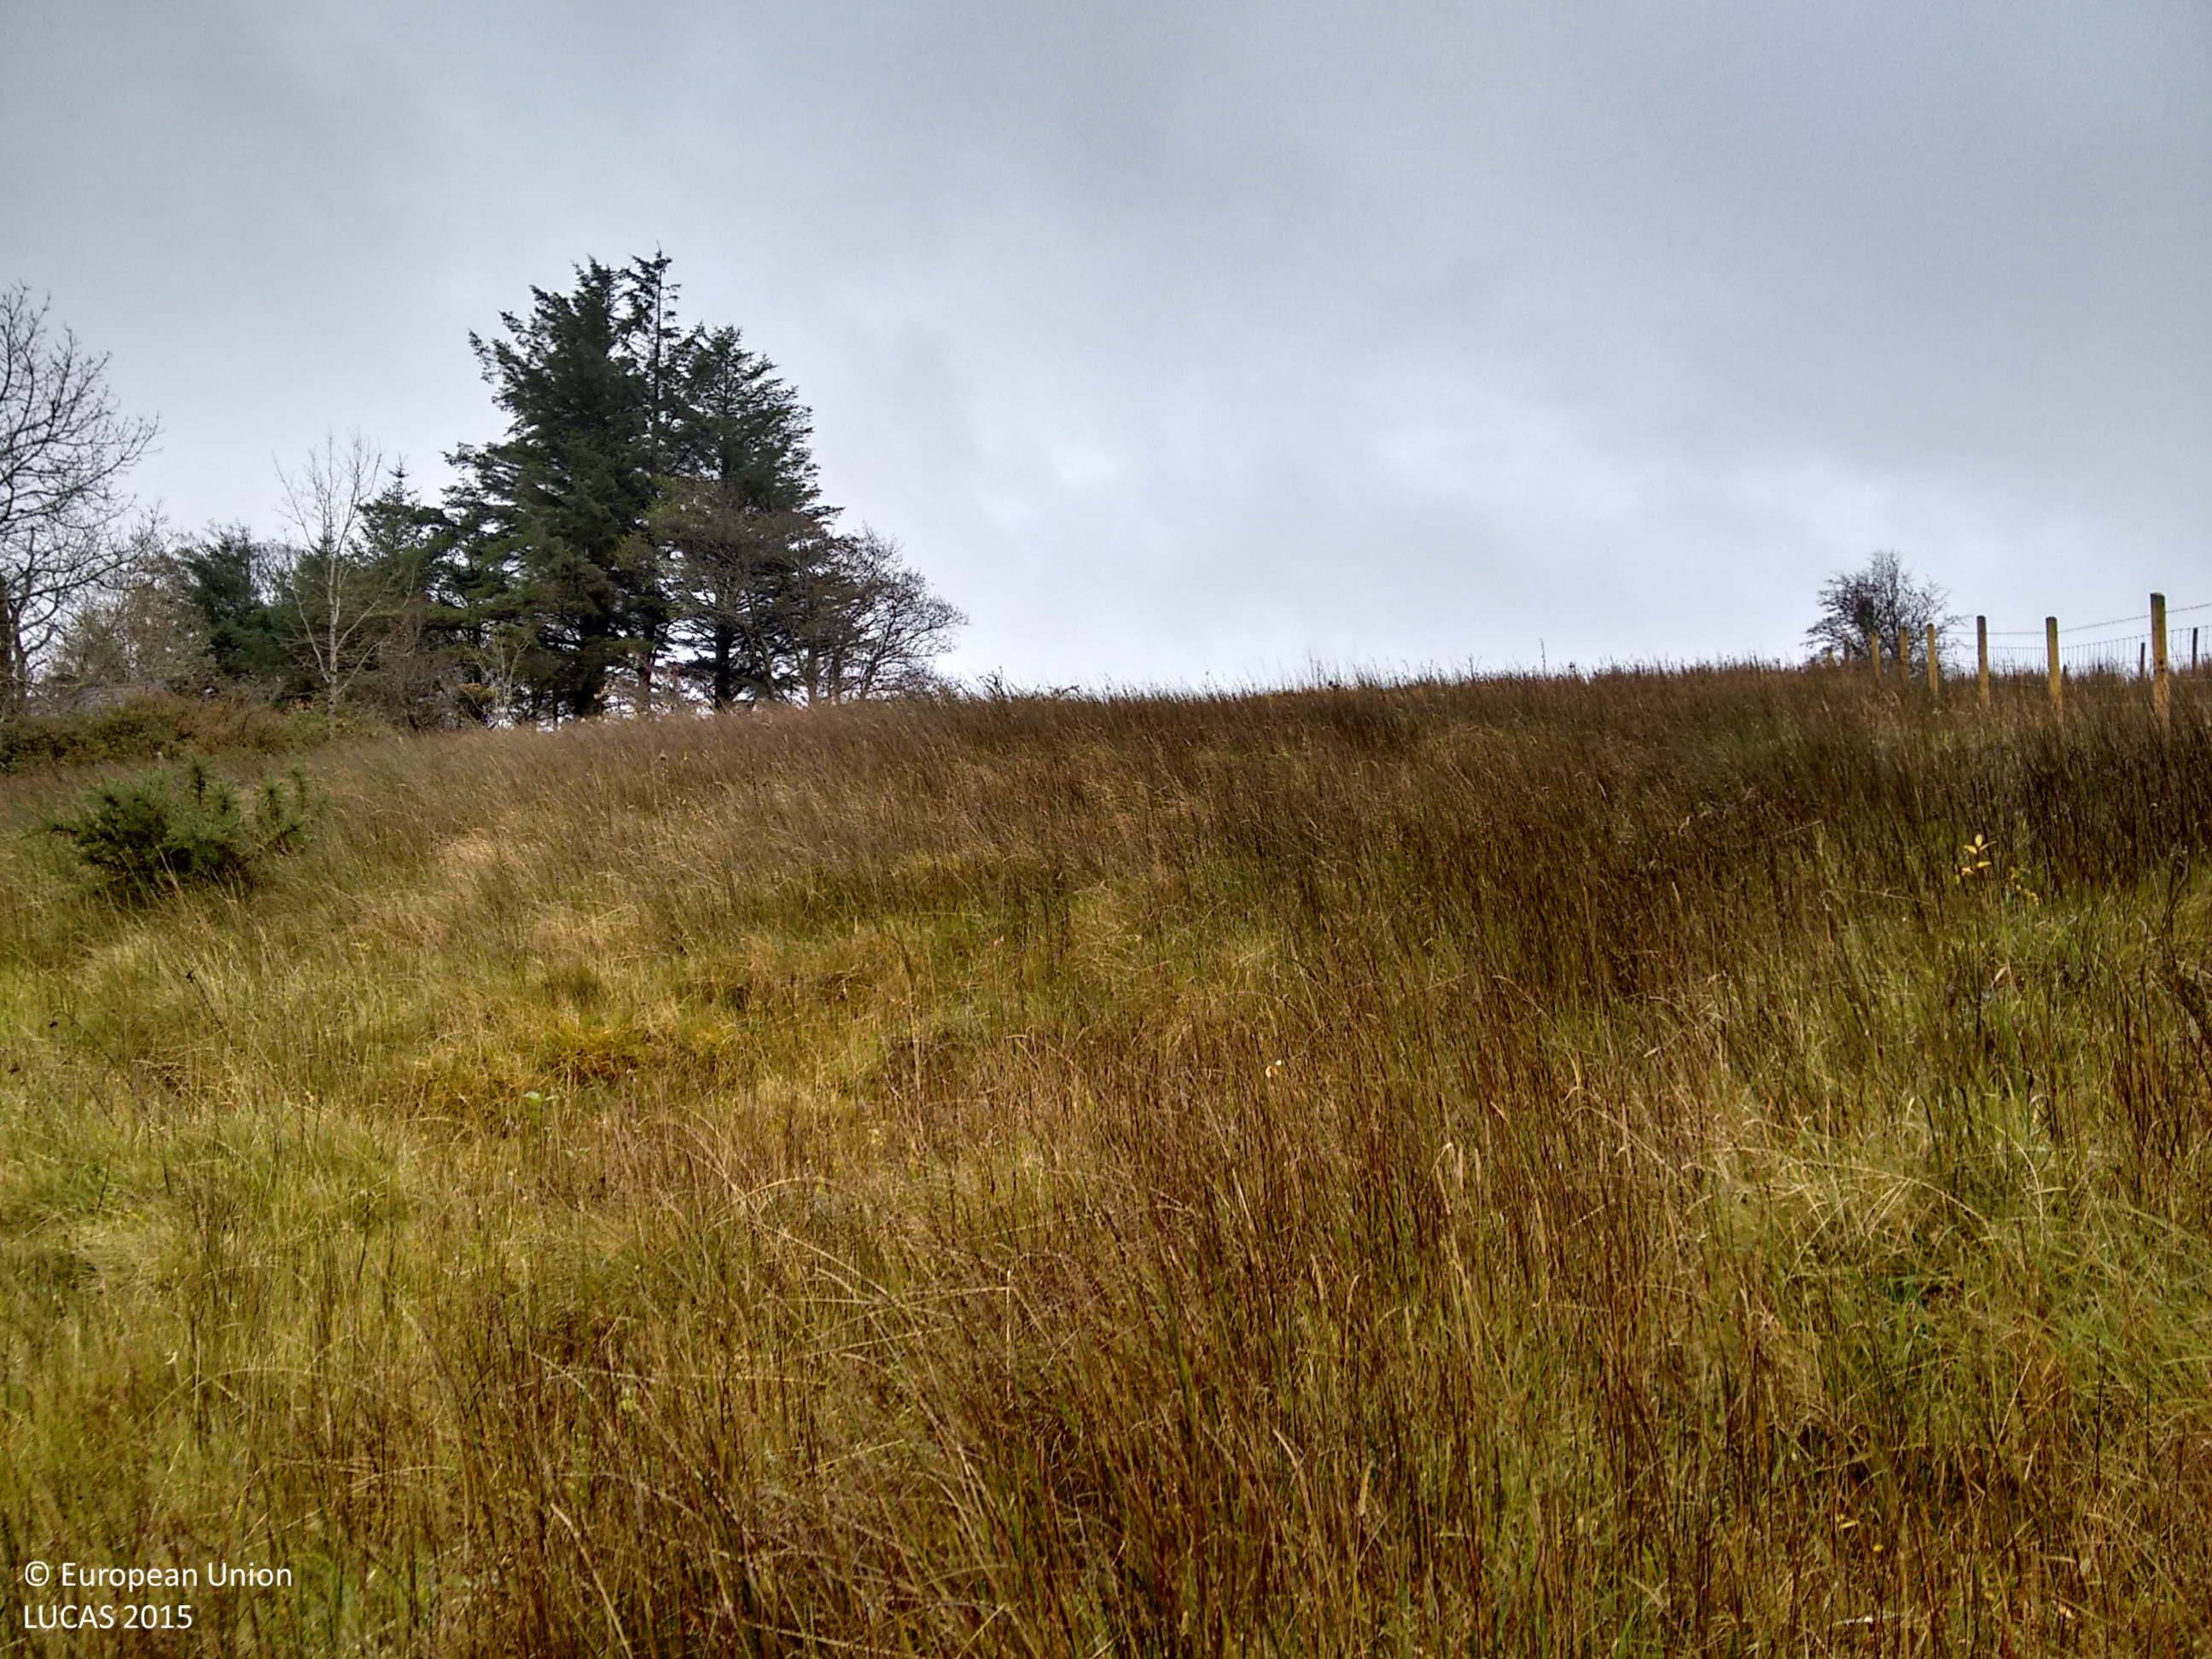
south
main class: Grassland
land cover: Grassland without tree/shrub cover
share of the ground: > 75 %
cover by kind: herbaceous plants 100 %
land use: Agriculture (excluding fallow land and kitchen gardens)
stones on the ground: < 10 %
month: November
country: IE
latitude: 54.4123
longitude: -8.1605
